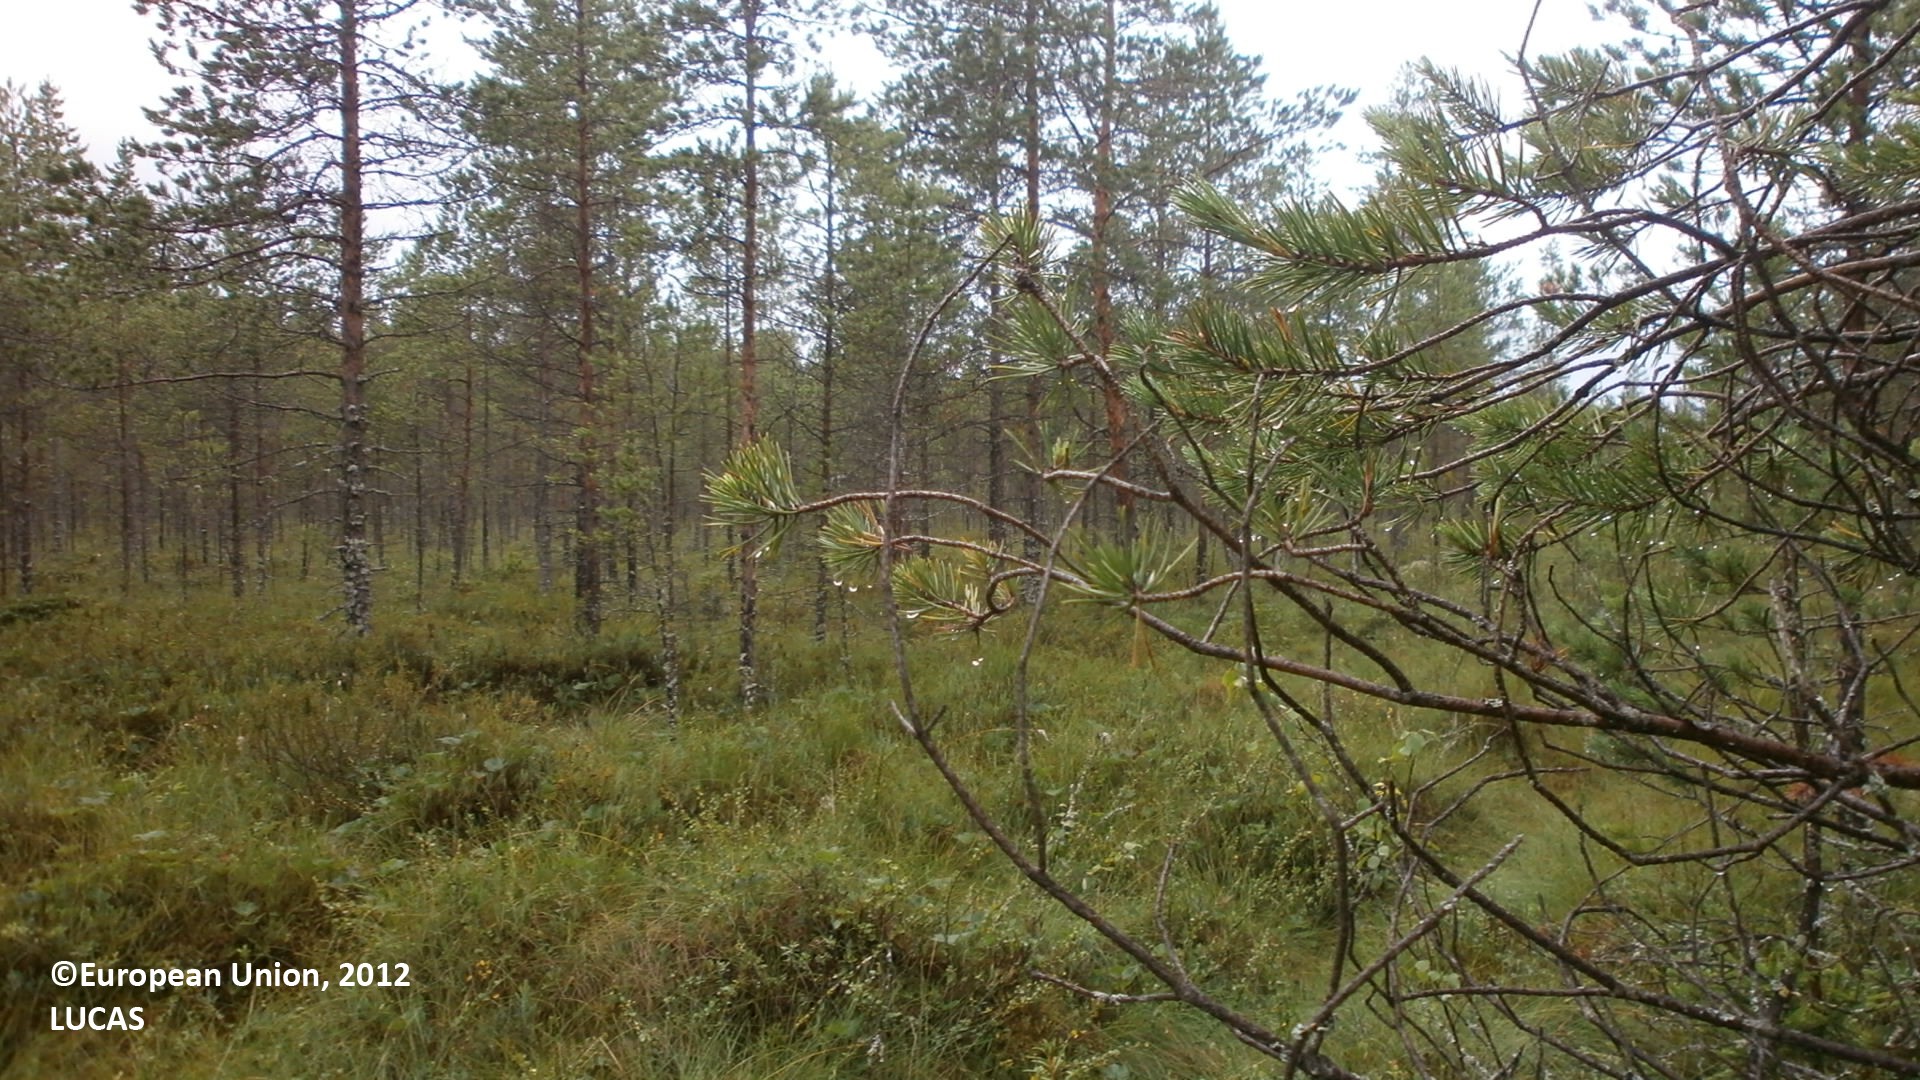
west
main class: Woodland
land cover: Pine dominated coniferous woodland
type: mire and swamp forests
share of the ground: 50 - 75 %
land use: Forestry
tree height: > 5 m
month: July
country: FI
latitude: 64.0733
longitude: 23.7333
